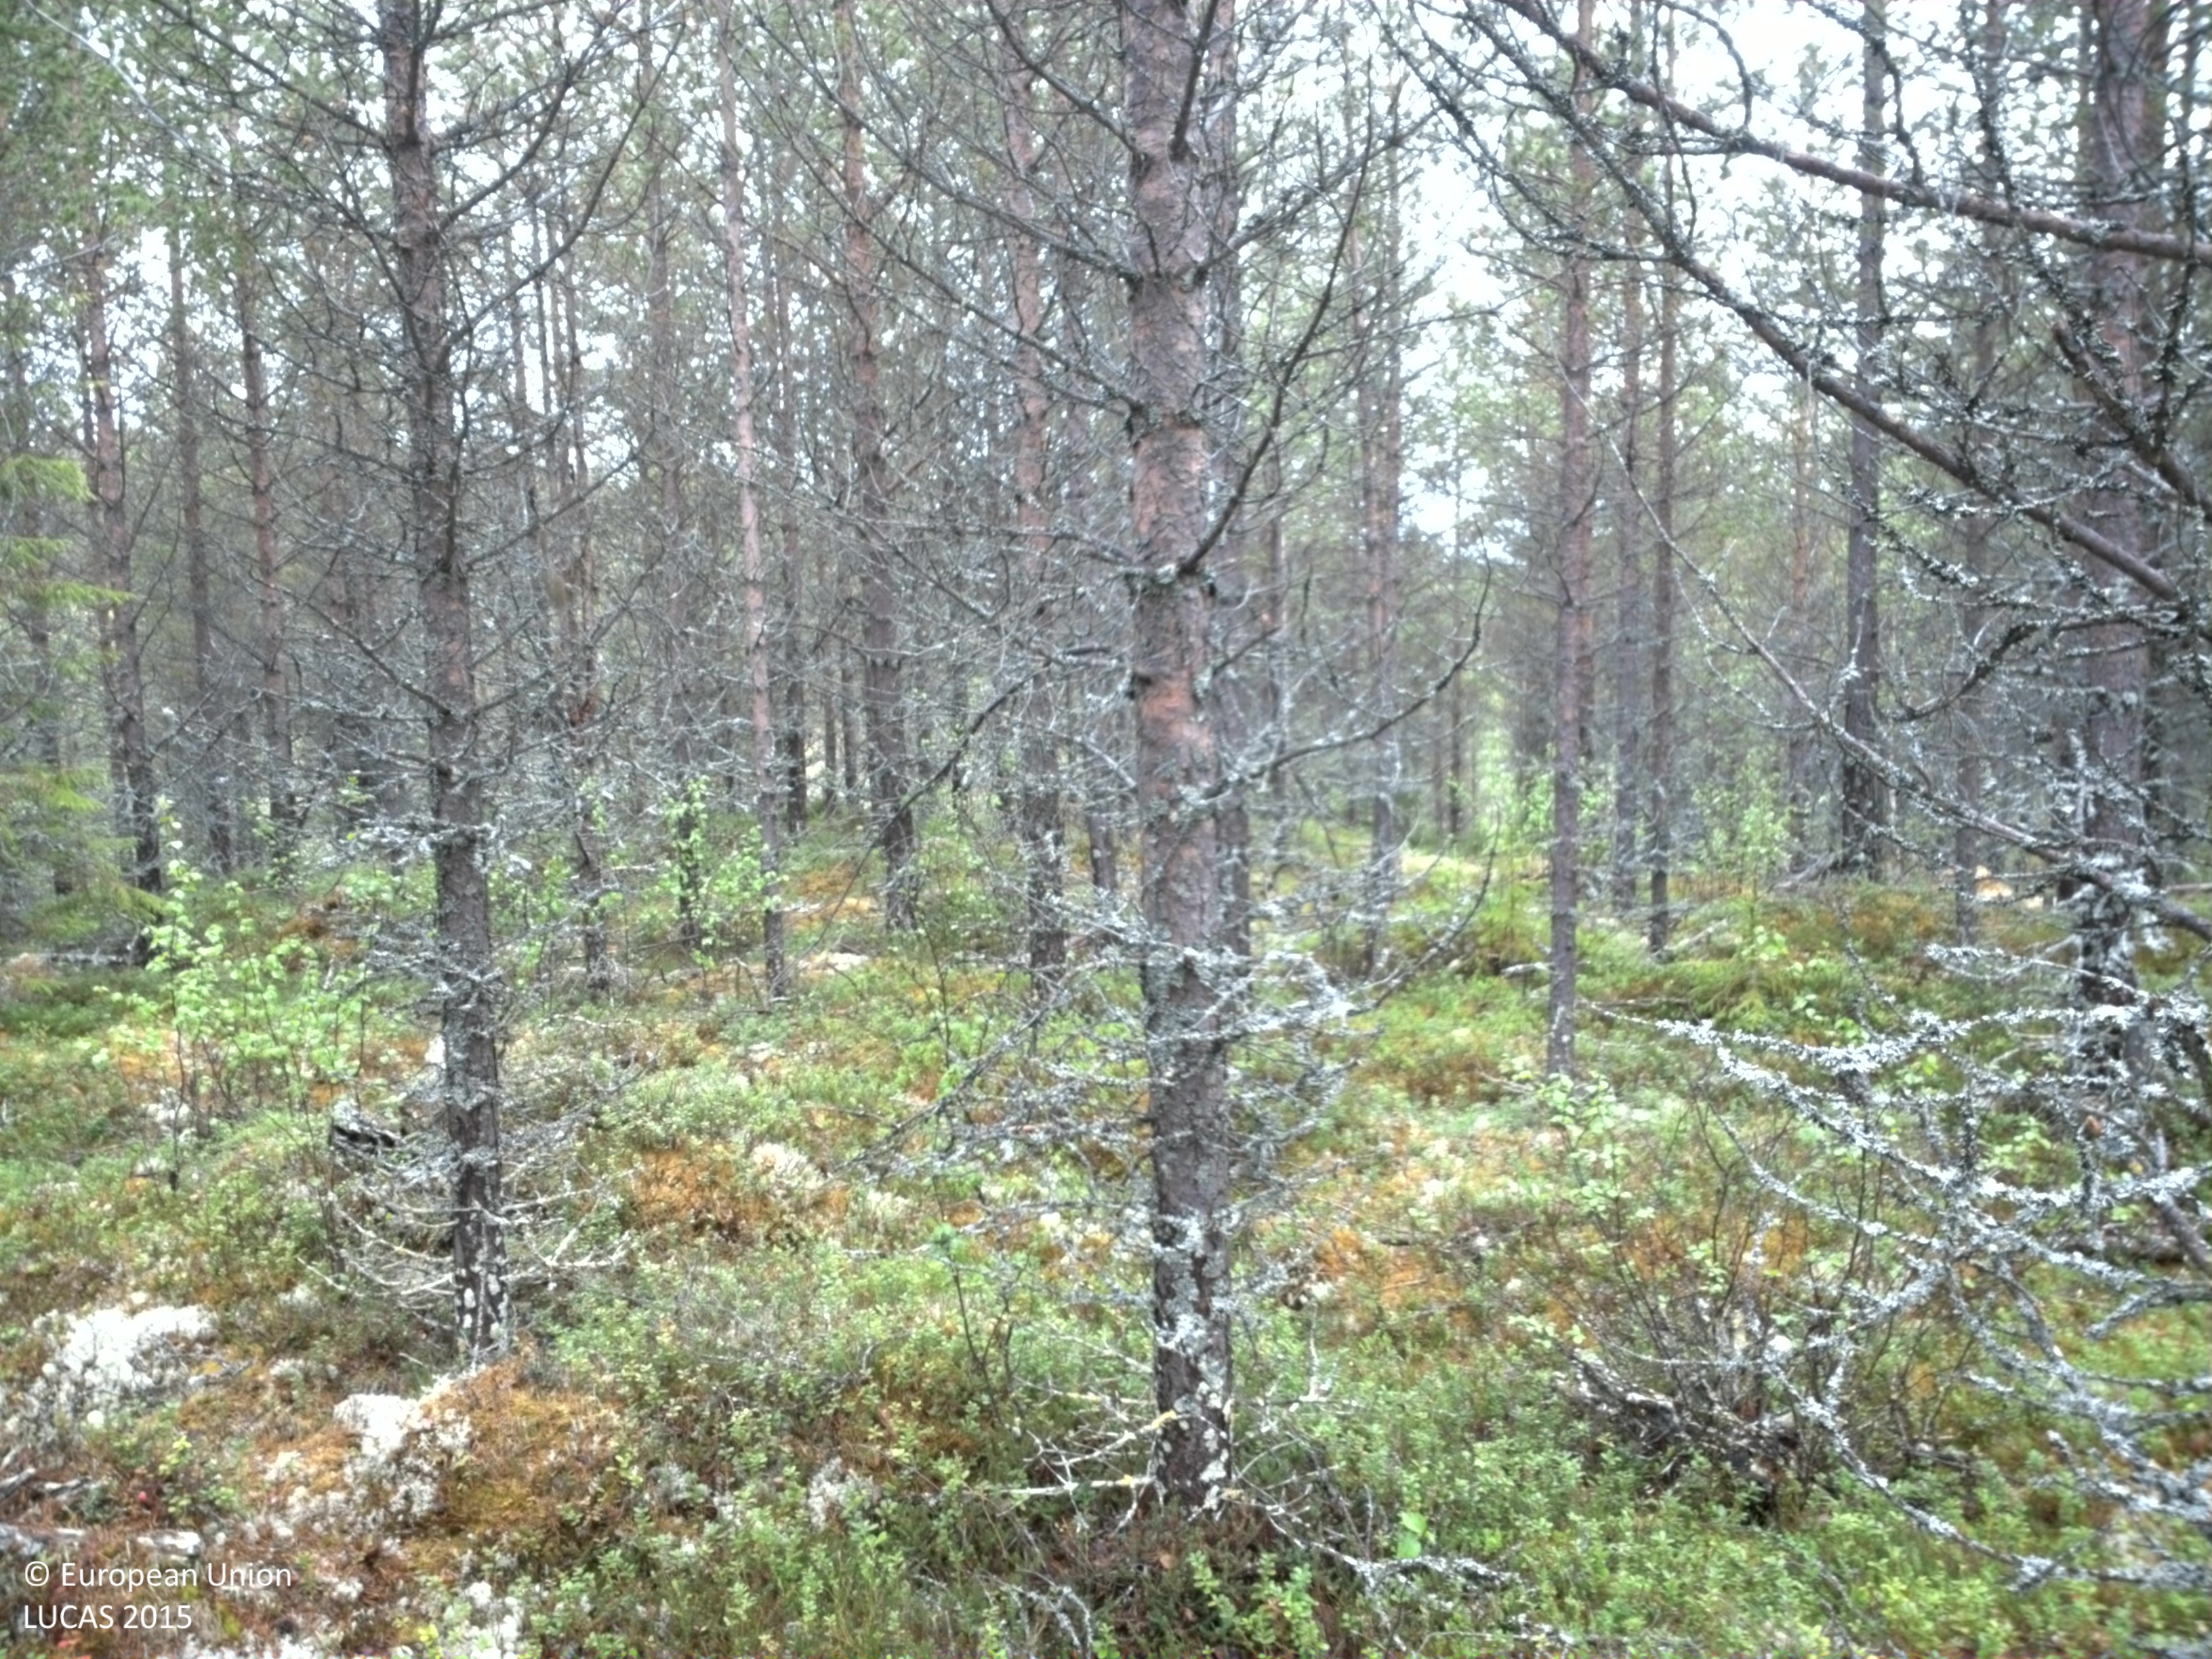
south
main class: Woodland
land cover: Pine dominated mixed woodland
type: boreal forest
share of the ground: 50 - 75 %
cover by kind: coniferous forest trees 40 %, shrubs 35 %, broadleaved forest trees 15 %, lichens and mosses 10 %
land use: Forestry
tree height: > 5 m
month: June
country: SE
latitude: 62.0640
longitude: 13.6018
